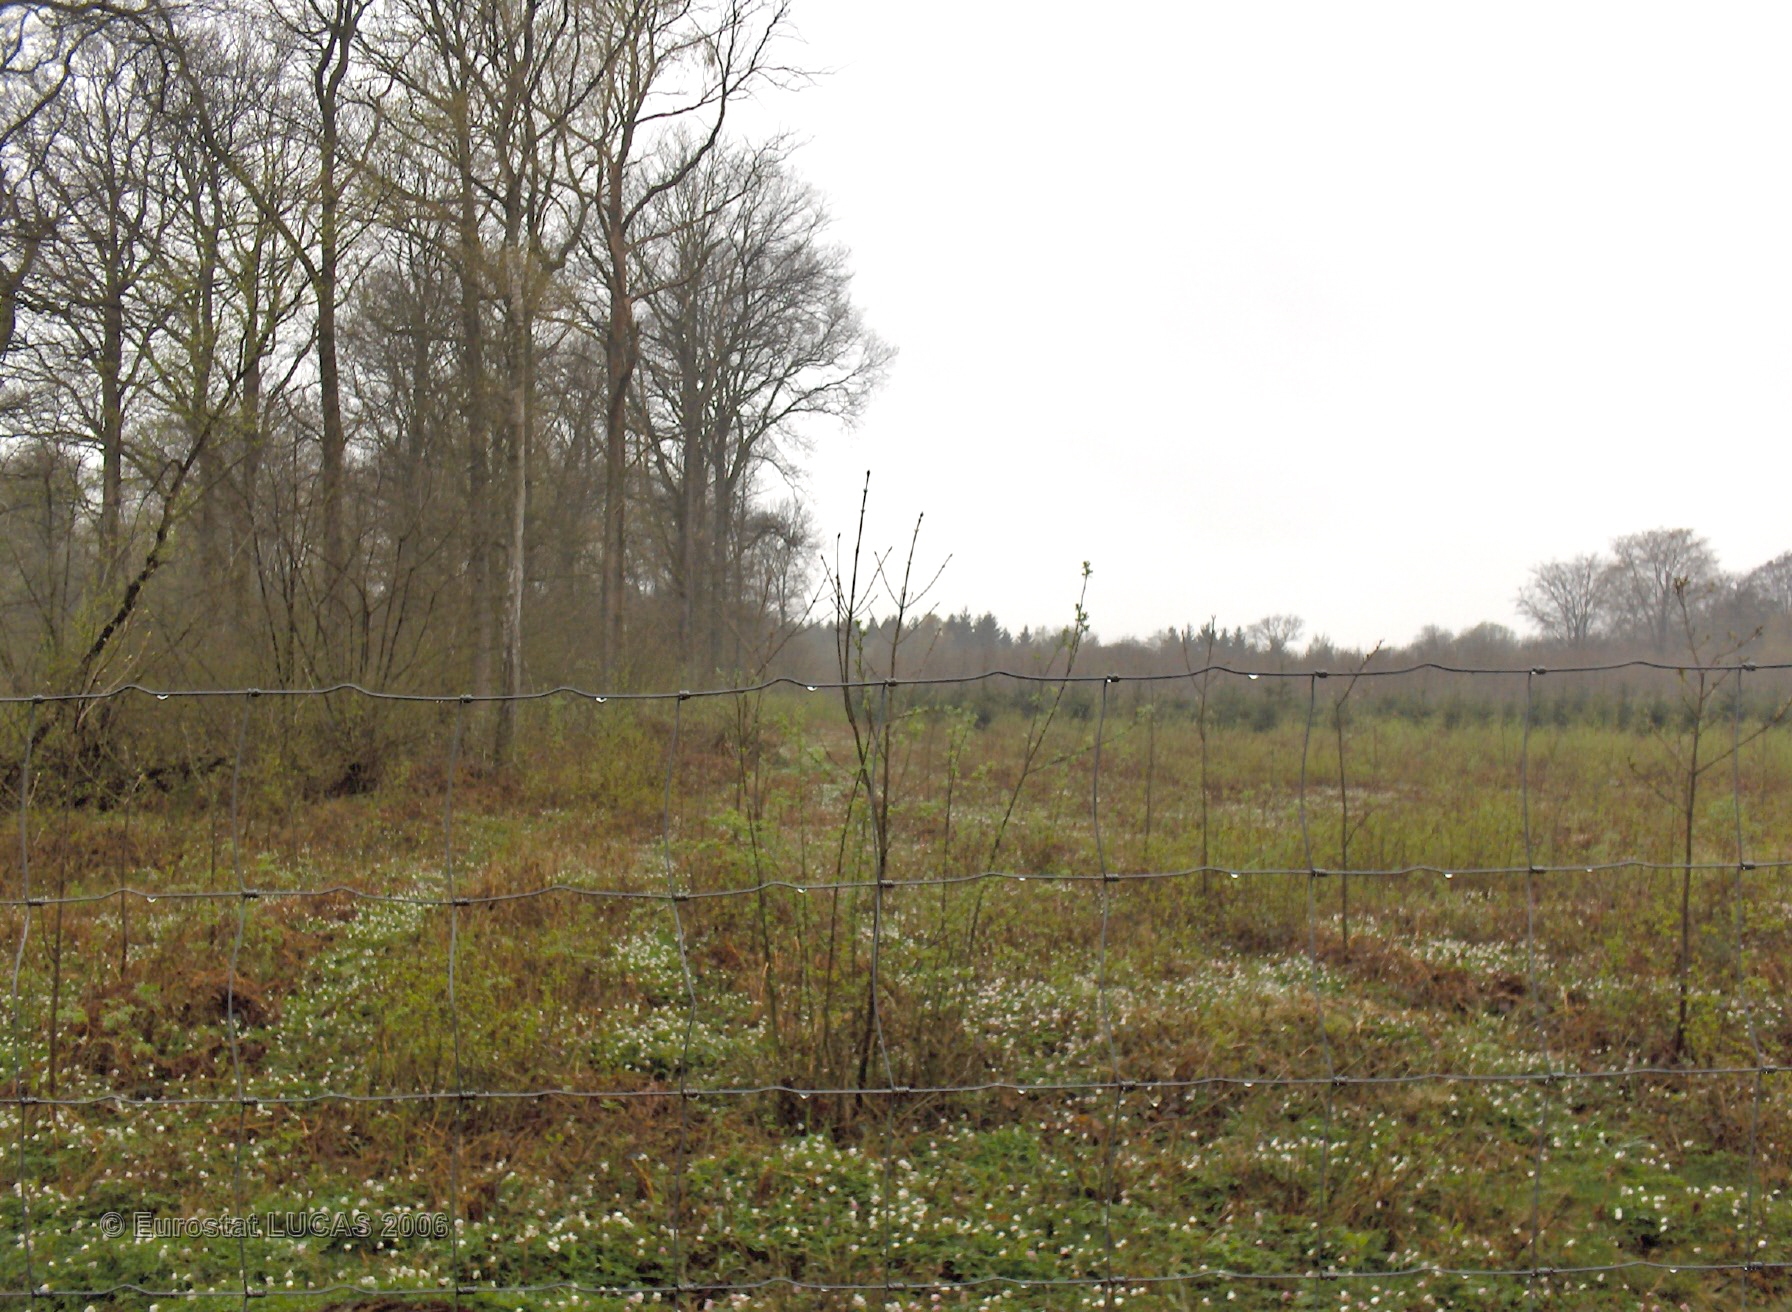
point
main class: Woodland
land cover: Mixed forest
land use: Forestry
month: April
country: BE
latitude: 50.3082
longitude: 4.5902
